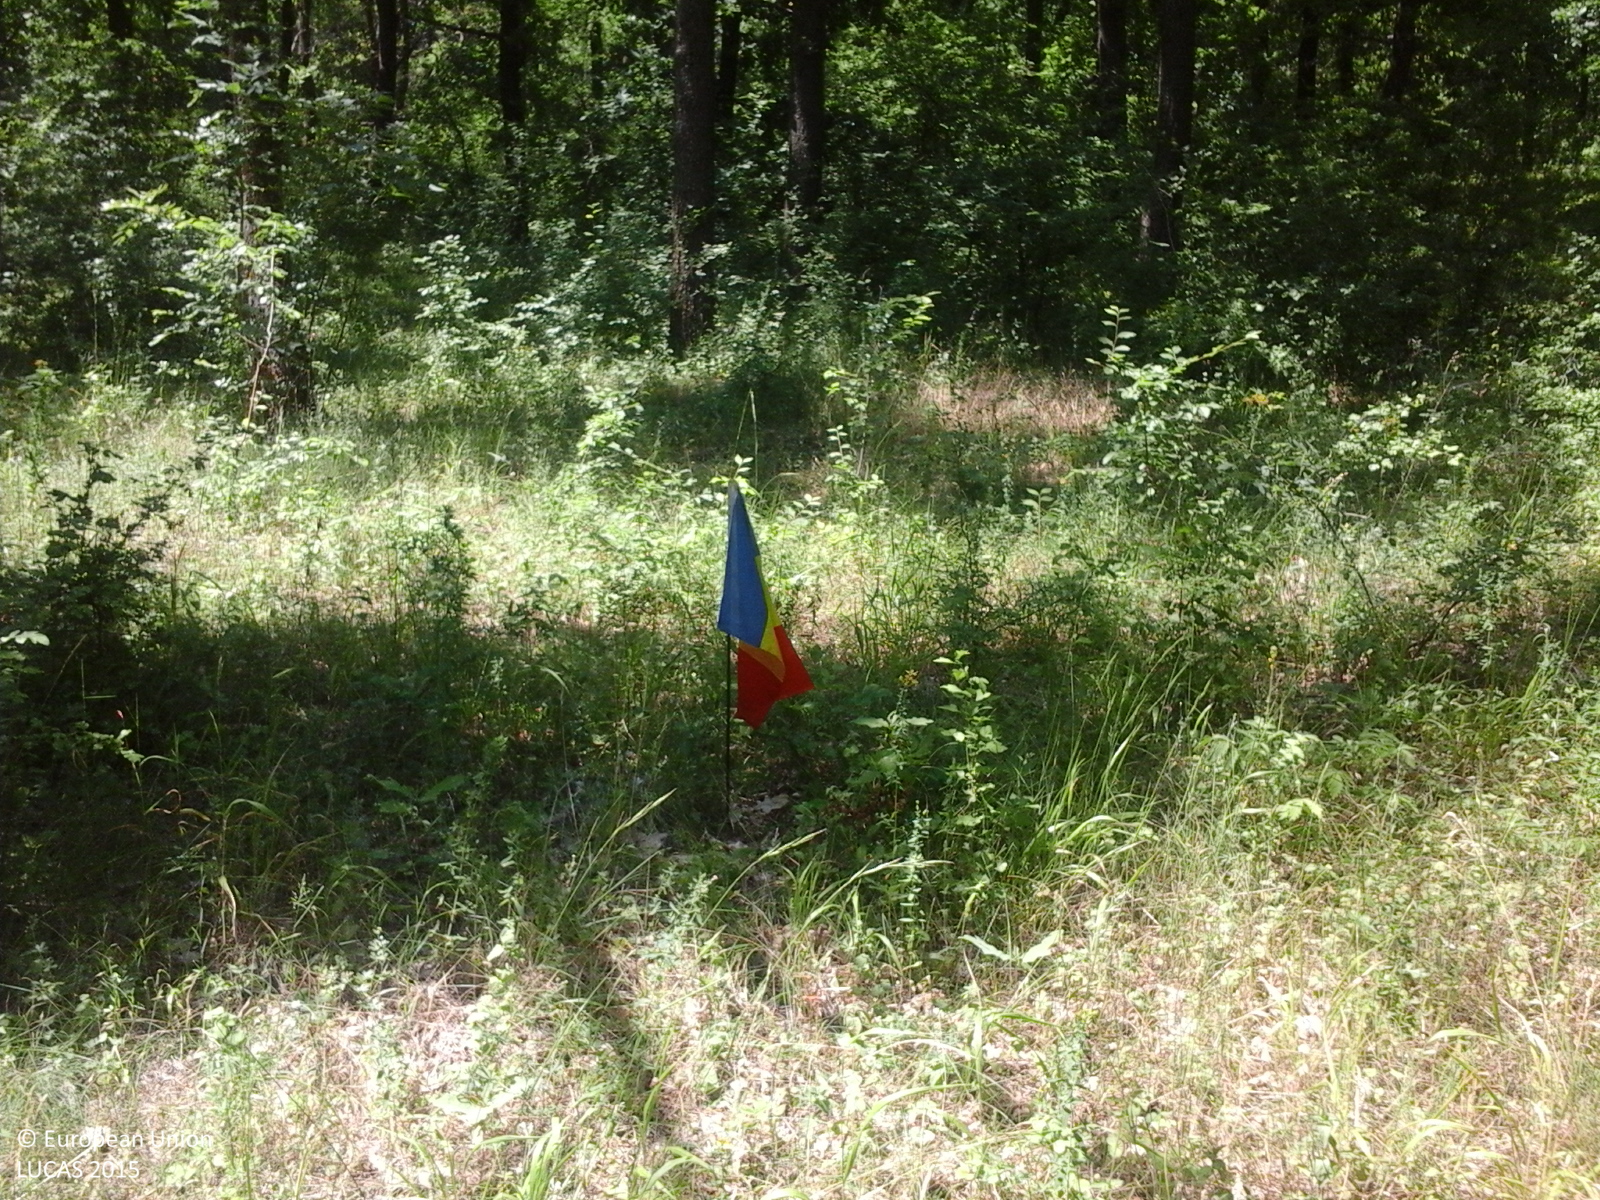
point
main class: Woodland
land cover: Broadleaved woodland
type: beech forest
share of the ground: > 75 %
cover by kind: broadleaved forest trees 100 %
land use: Forestry
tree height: > 5 m
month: June
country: RO
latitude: 46.8097
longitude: 27.9363
